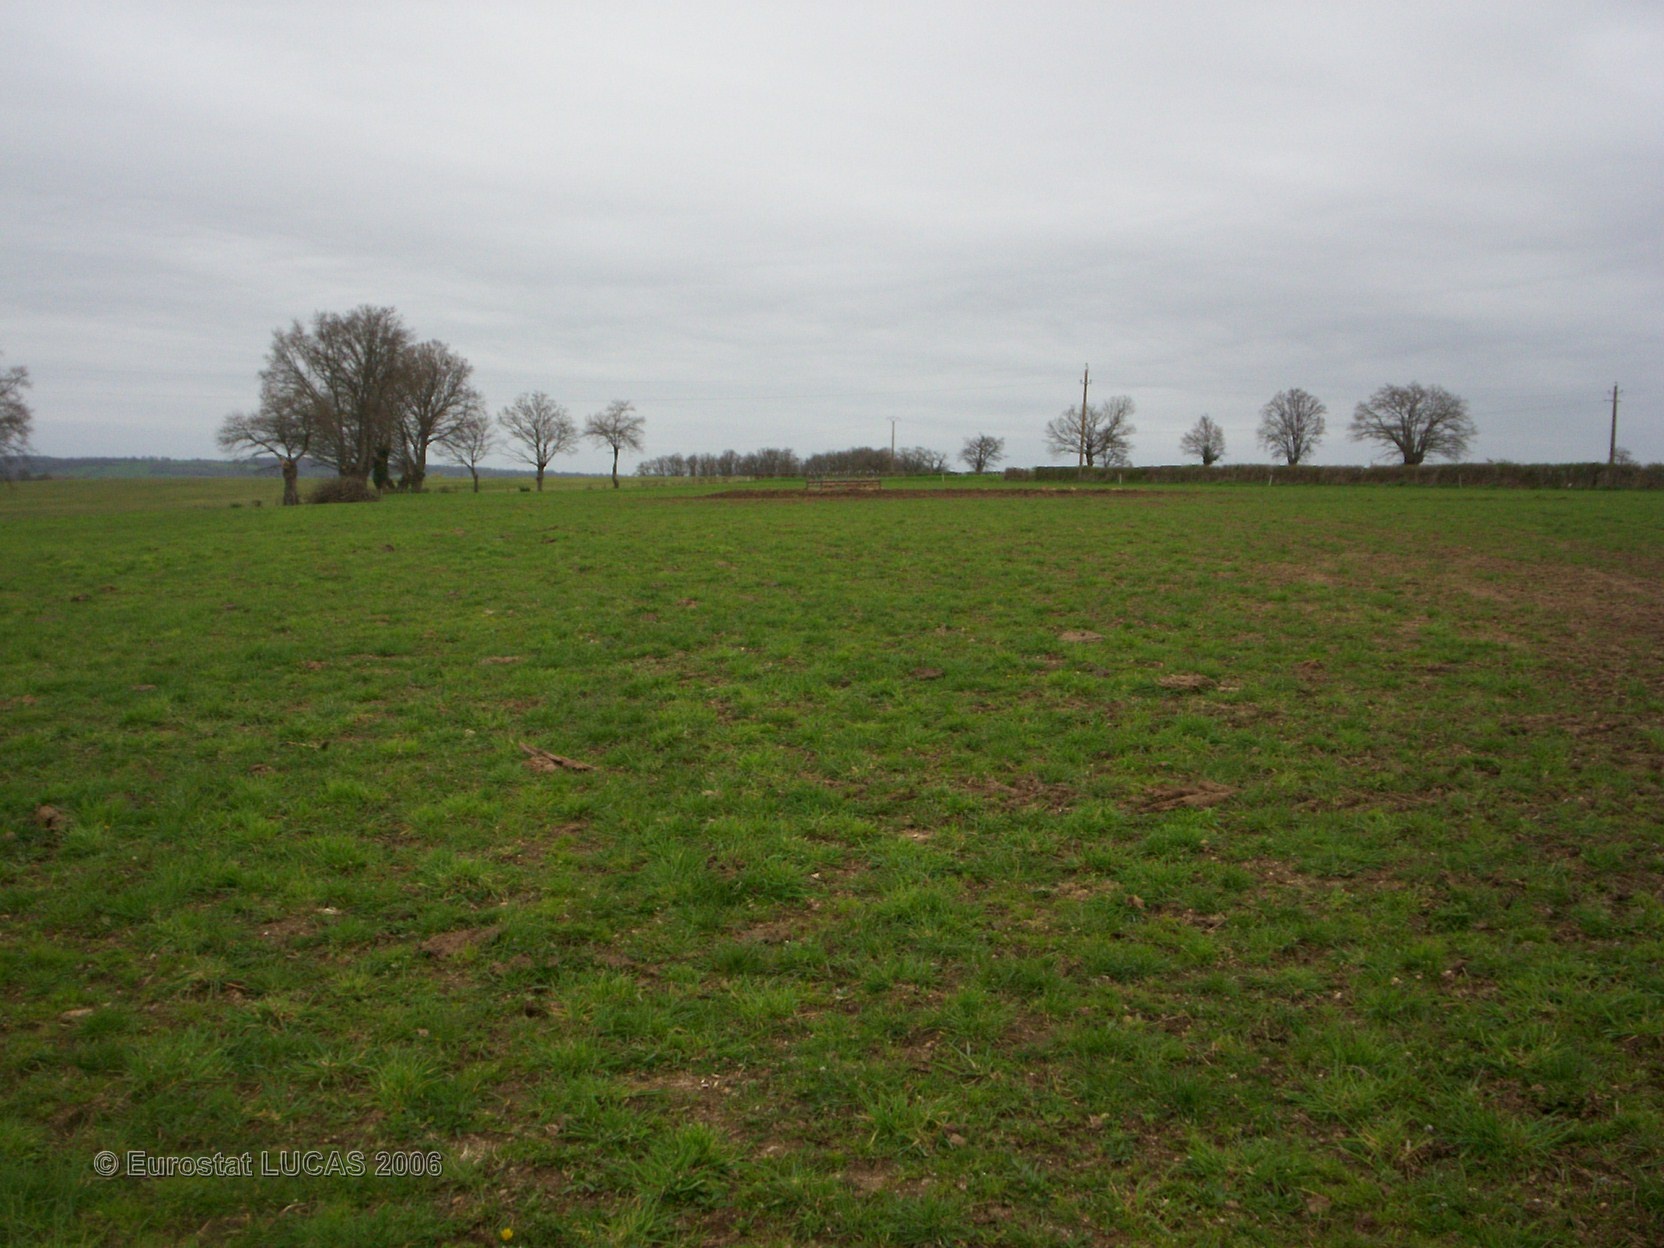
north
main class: Grassland
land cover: Grassland without tree/shrub cover
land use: Agriculture (excluding fallow land and kitchen gardens)
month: April
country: FR
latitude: 46.7085
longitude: 3.1299
